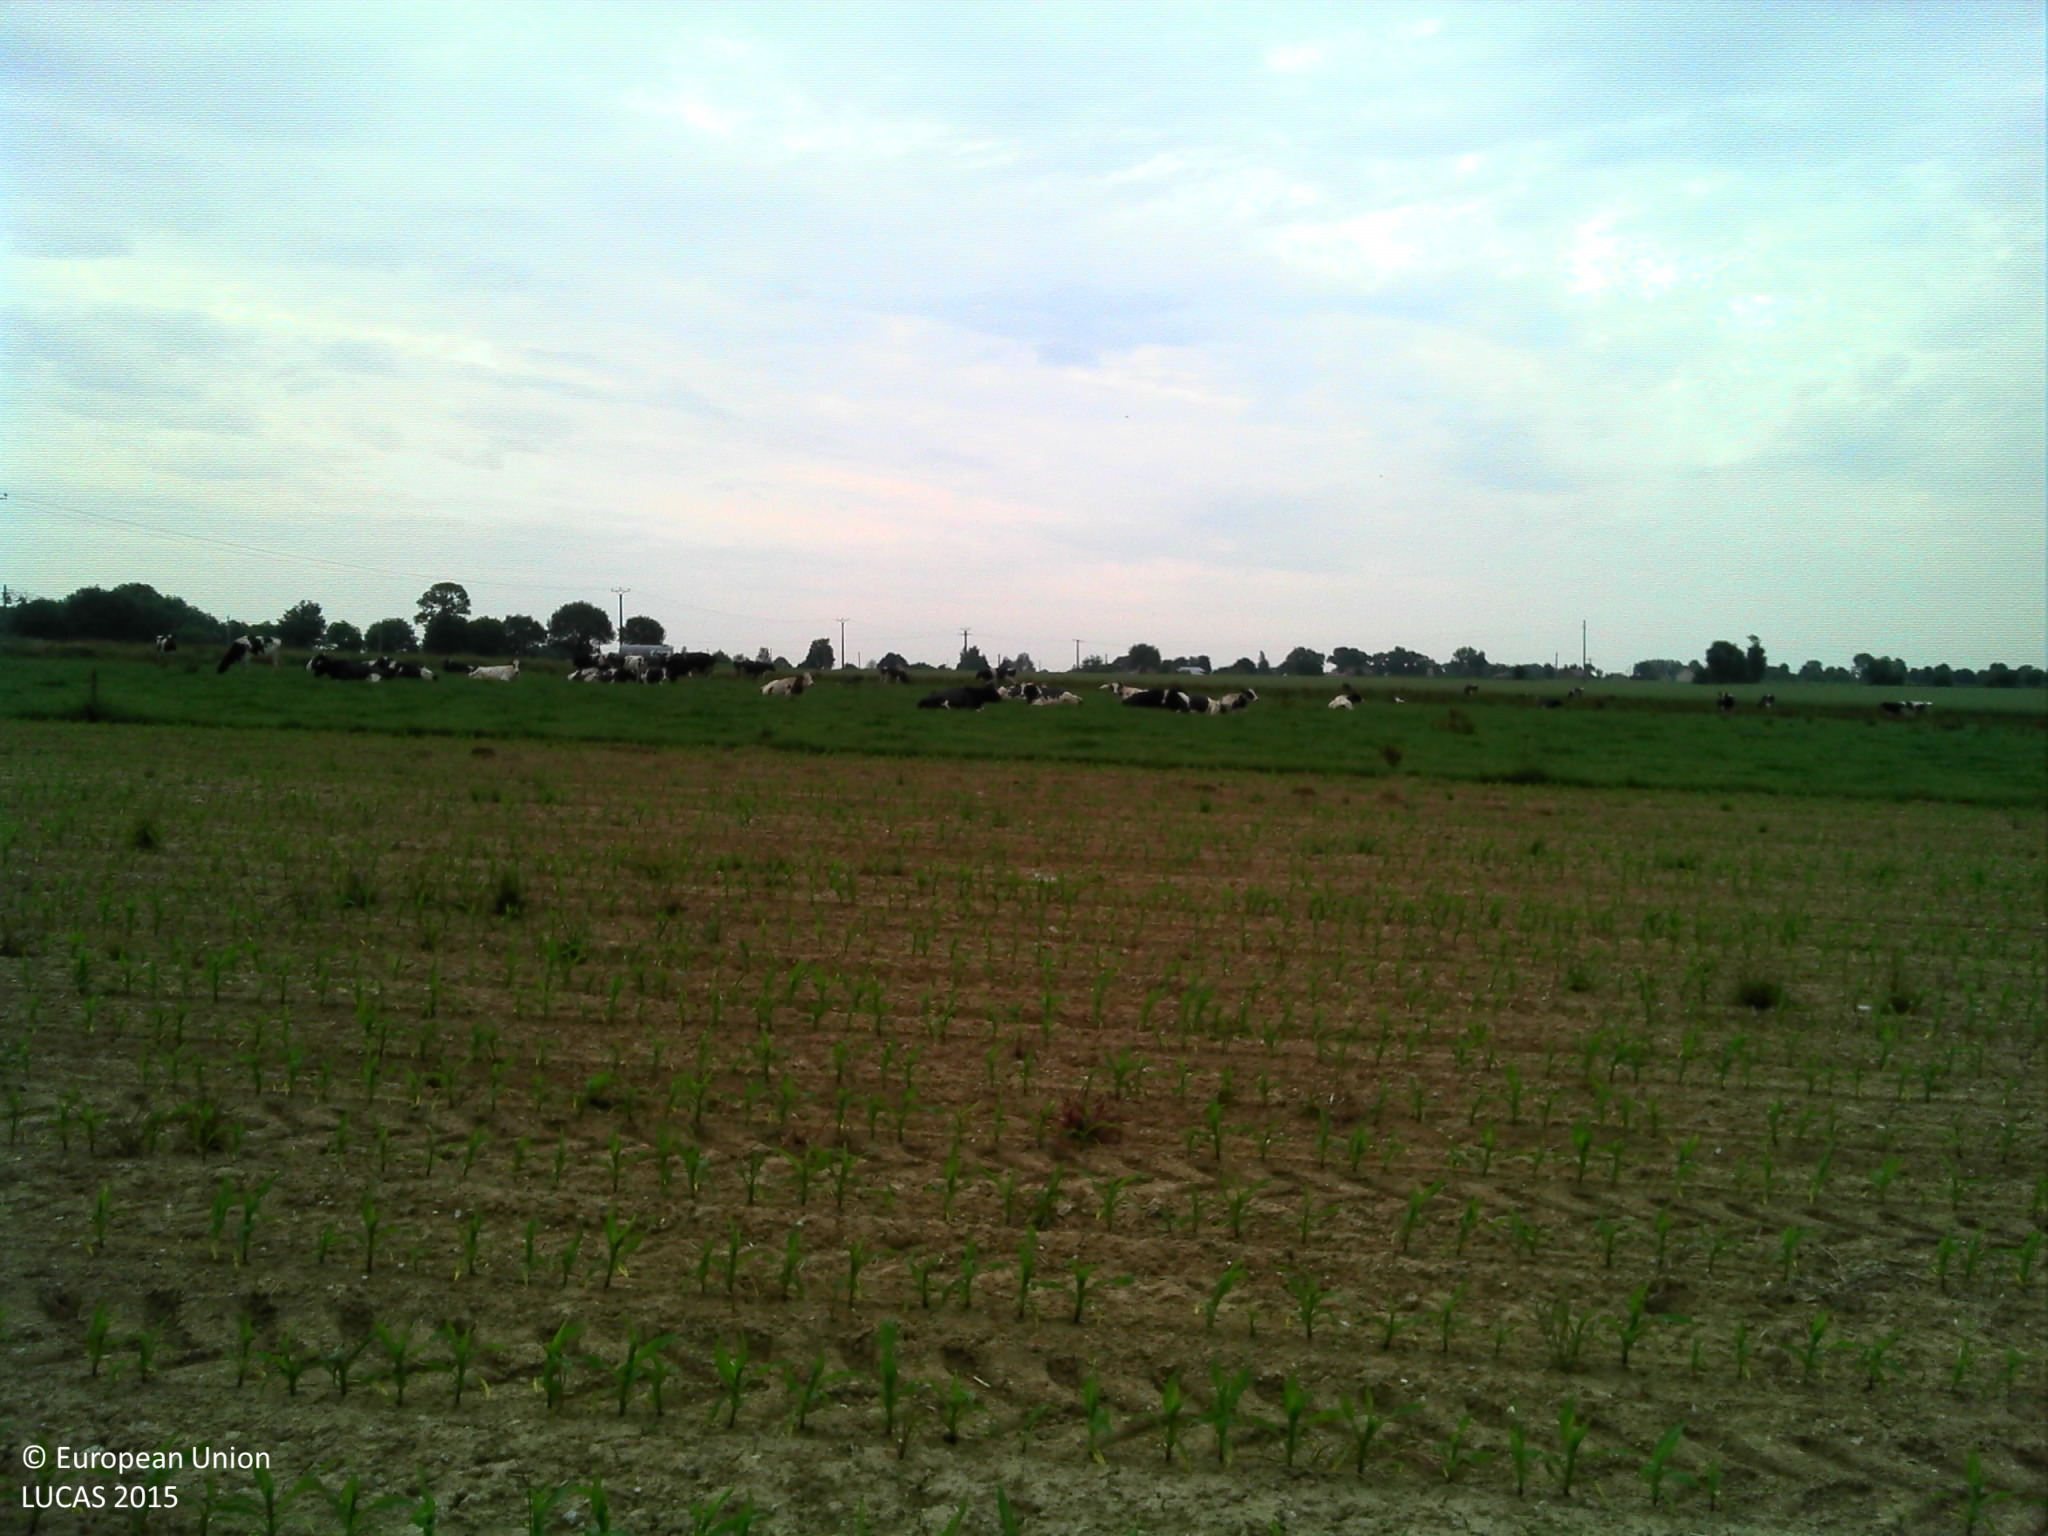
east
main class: Cropland
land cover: Maize
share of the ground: 10 - 25 %
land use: Agriculture (excluding fallow land and kitchen gardens)
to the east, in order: Maize; Fences; Grassland without tree/shrub cover; Fences; Common wheat
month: June
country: FR
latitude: 48.1709
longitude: -2.1164
